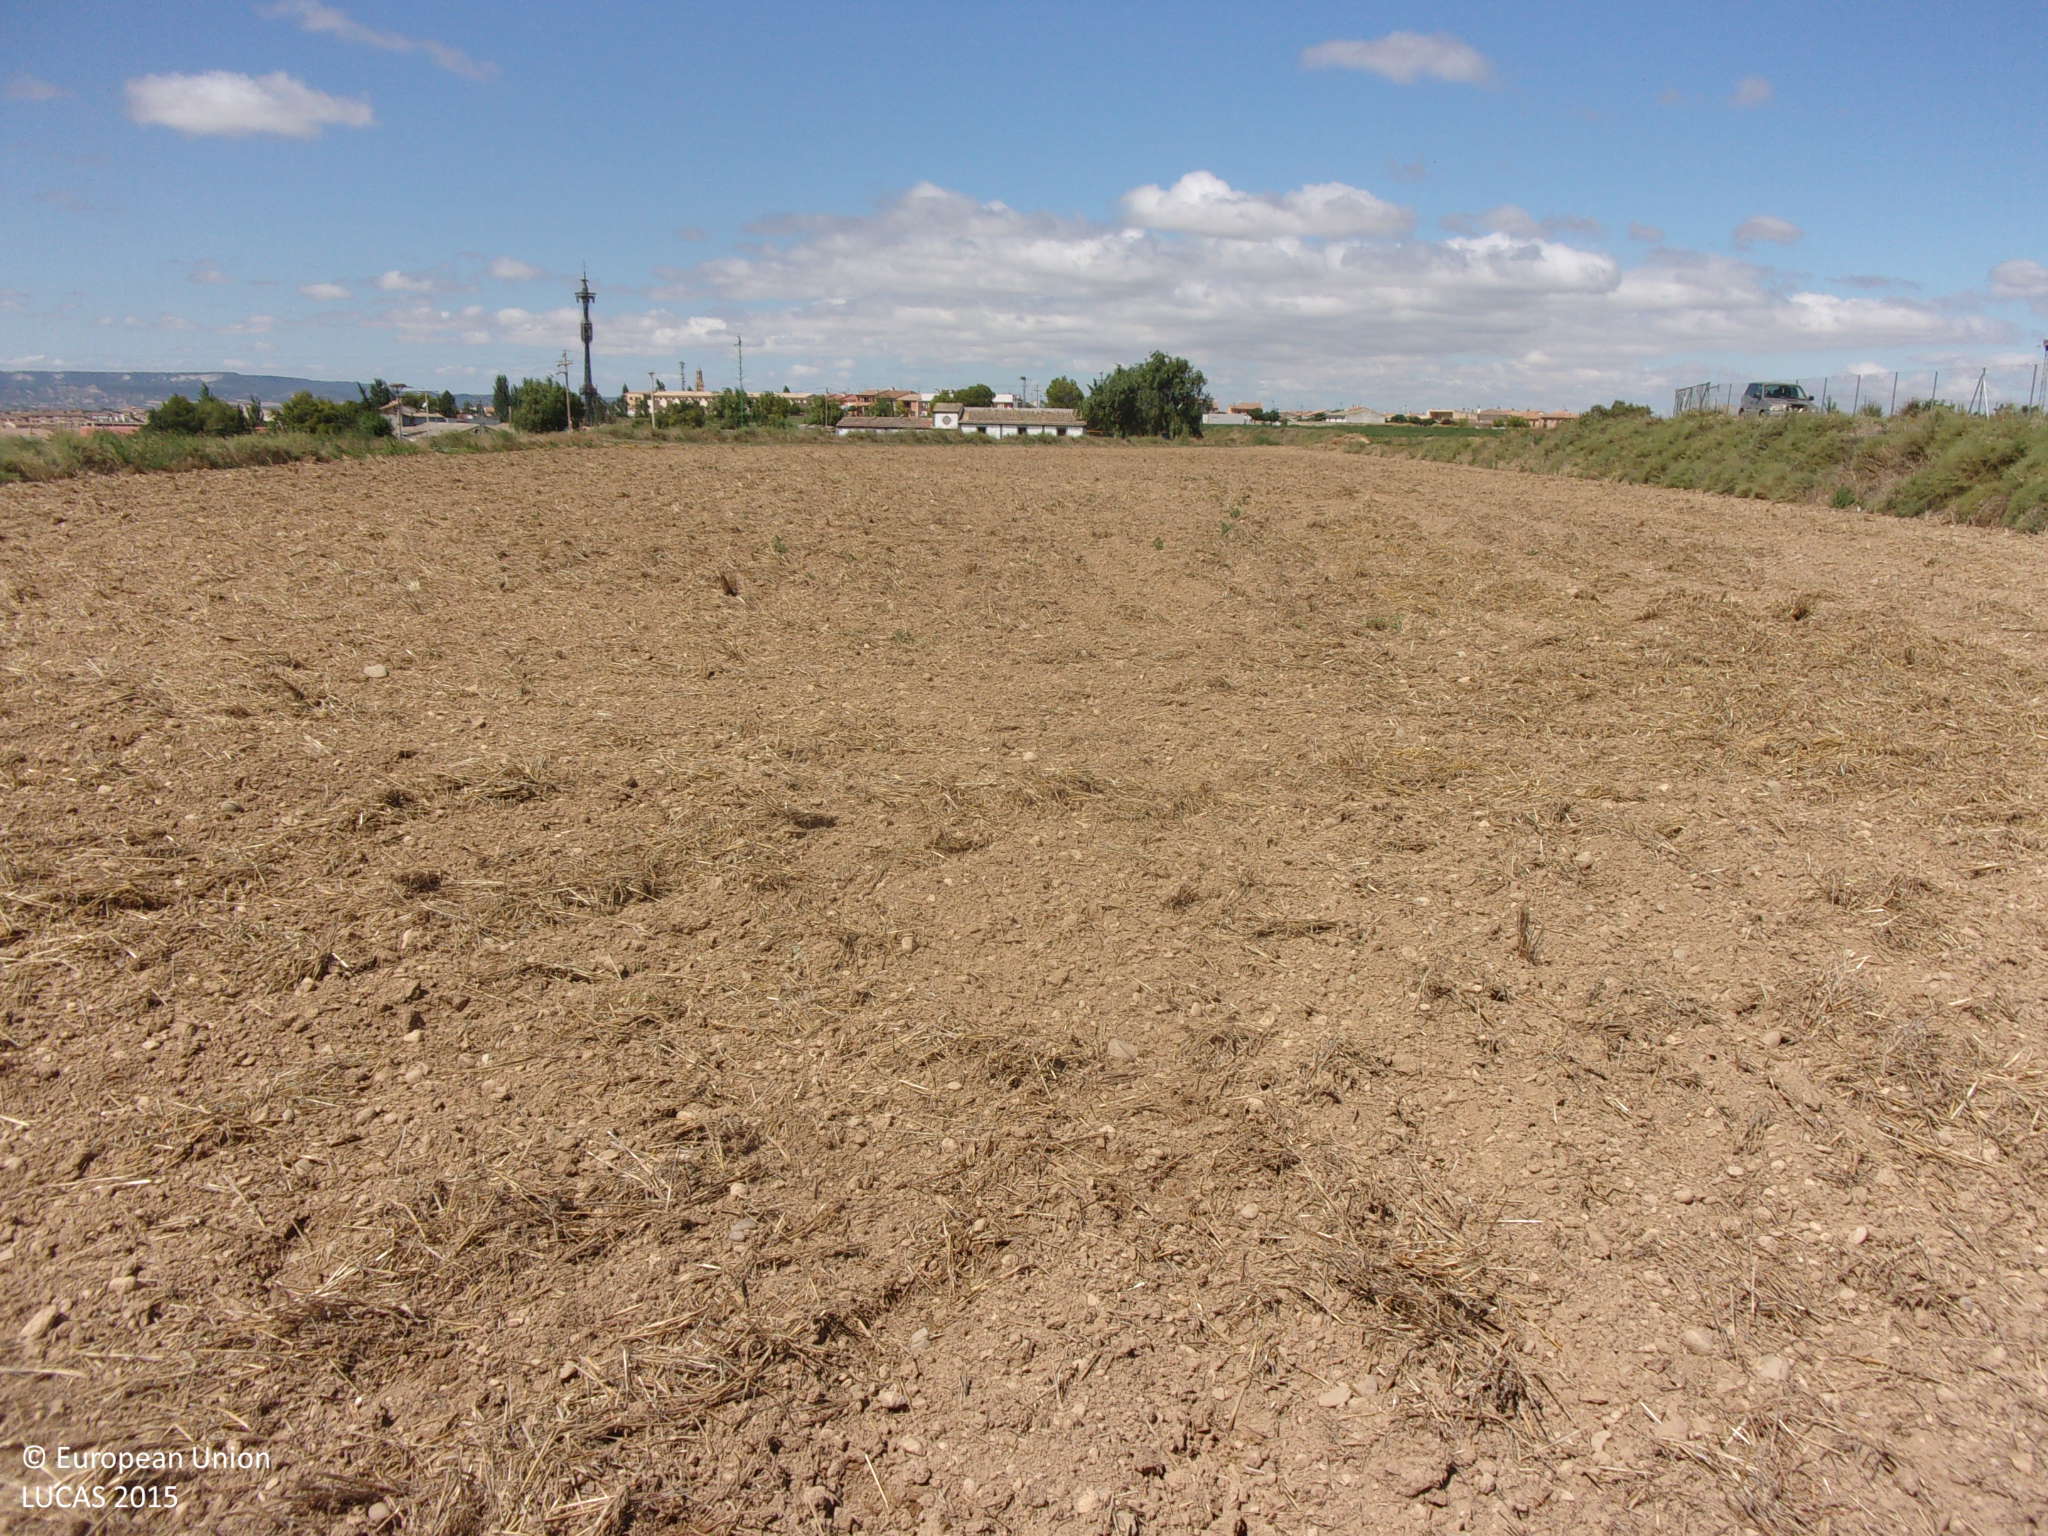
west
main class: Cropland
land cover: Barley
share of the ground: < 10 %
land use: Agriculture (excluding fallow land and kitchen gardens)
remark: Harvested field
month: August
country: ES
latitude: 42.1307
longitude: -1.1215
